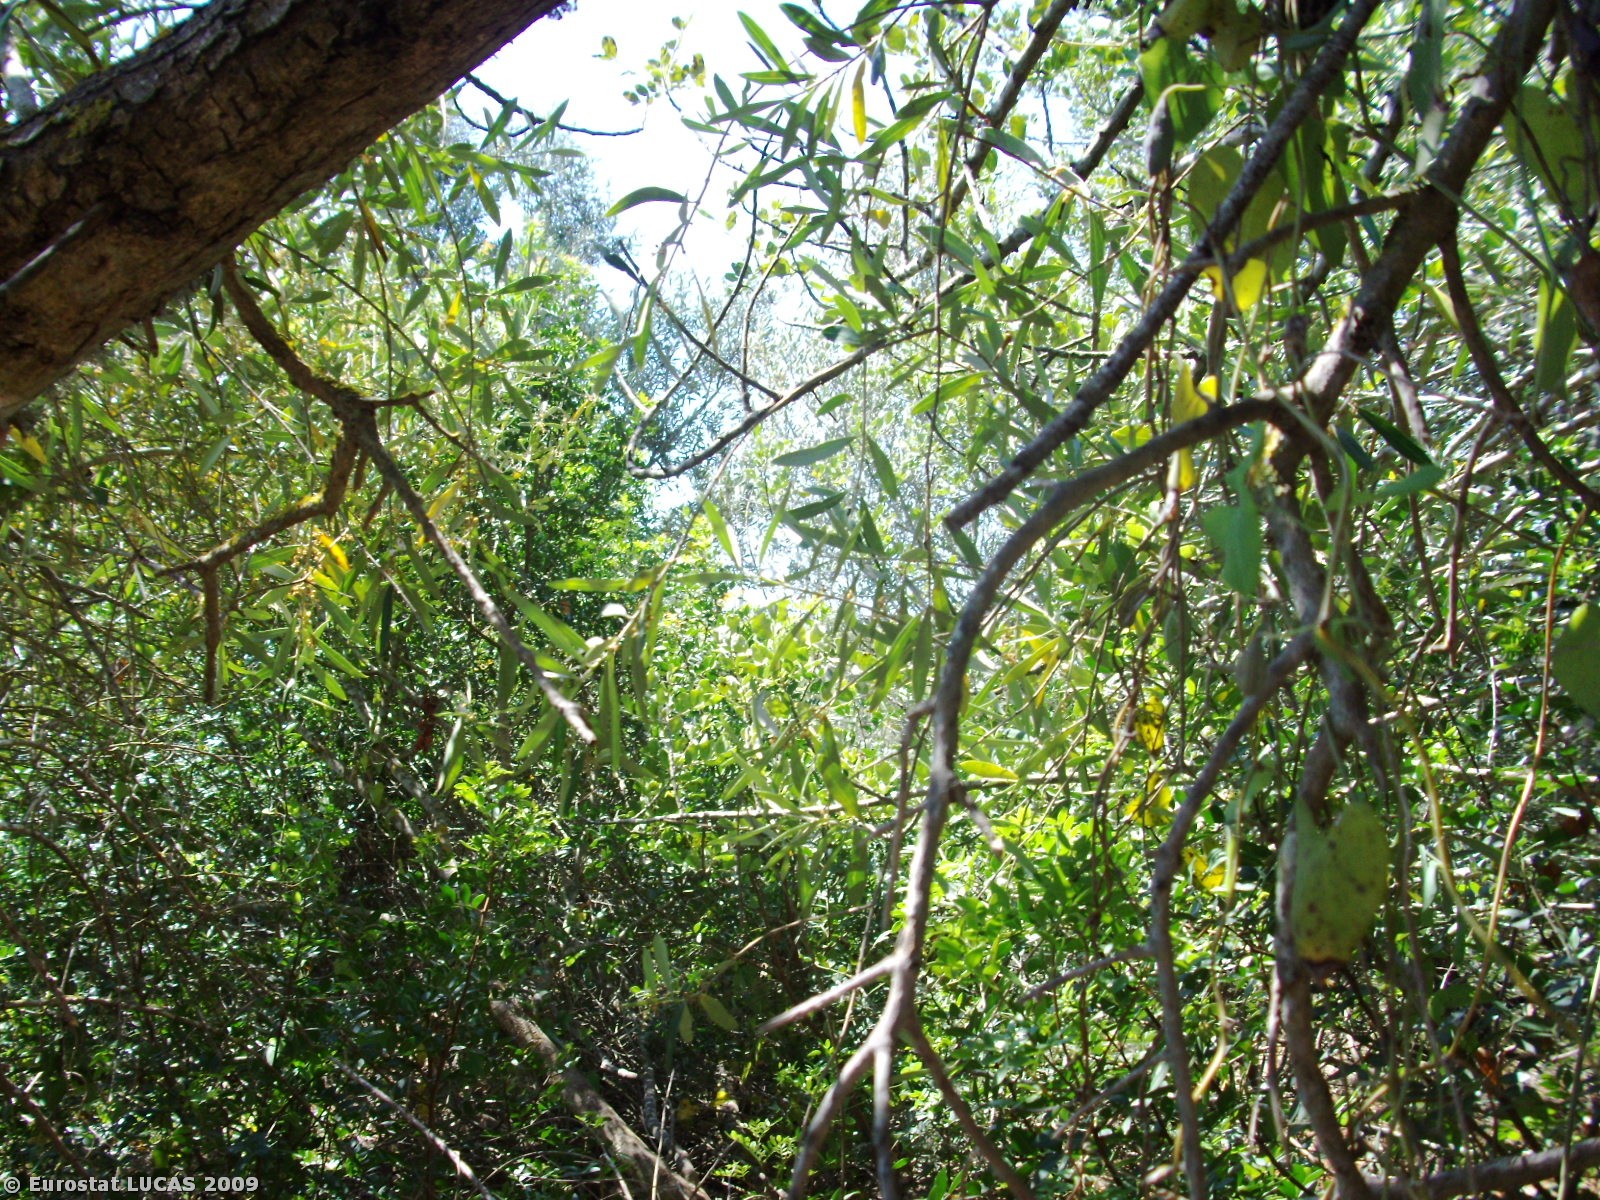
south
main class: Cropland
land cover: Permanent industrial crops
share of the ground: 25 - 50 %
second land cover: Spontaneously vegetated surfaces
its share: 50 - 75 %
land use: Agriculture (excluding fallow land and kitchen gardens)
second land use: Unused
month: May
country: PT
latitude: 37.1999
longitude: -8.2838
